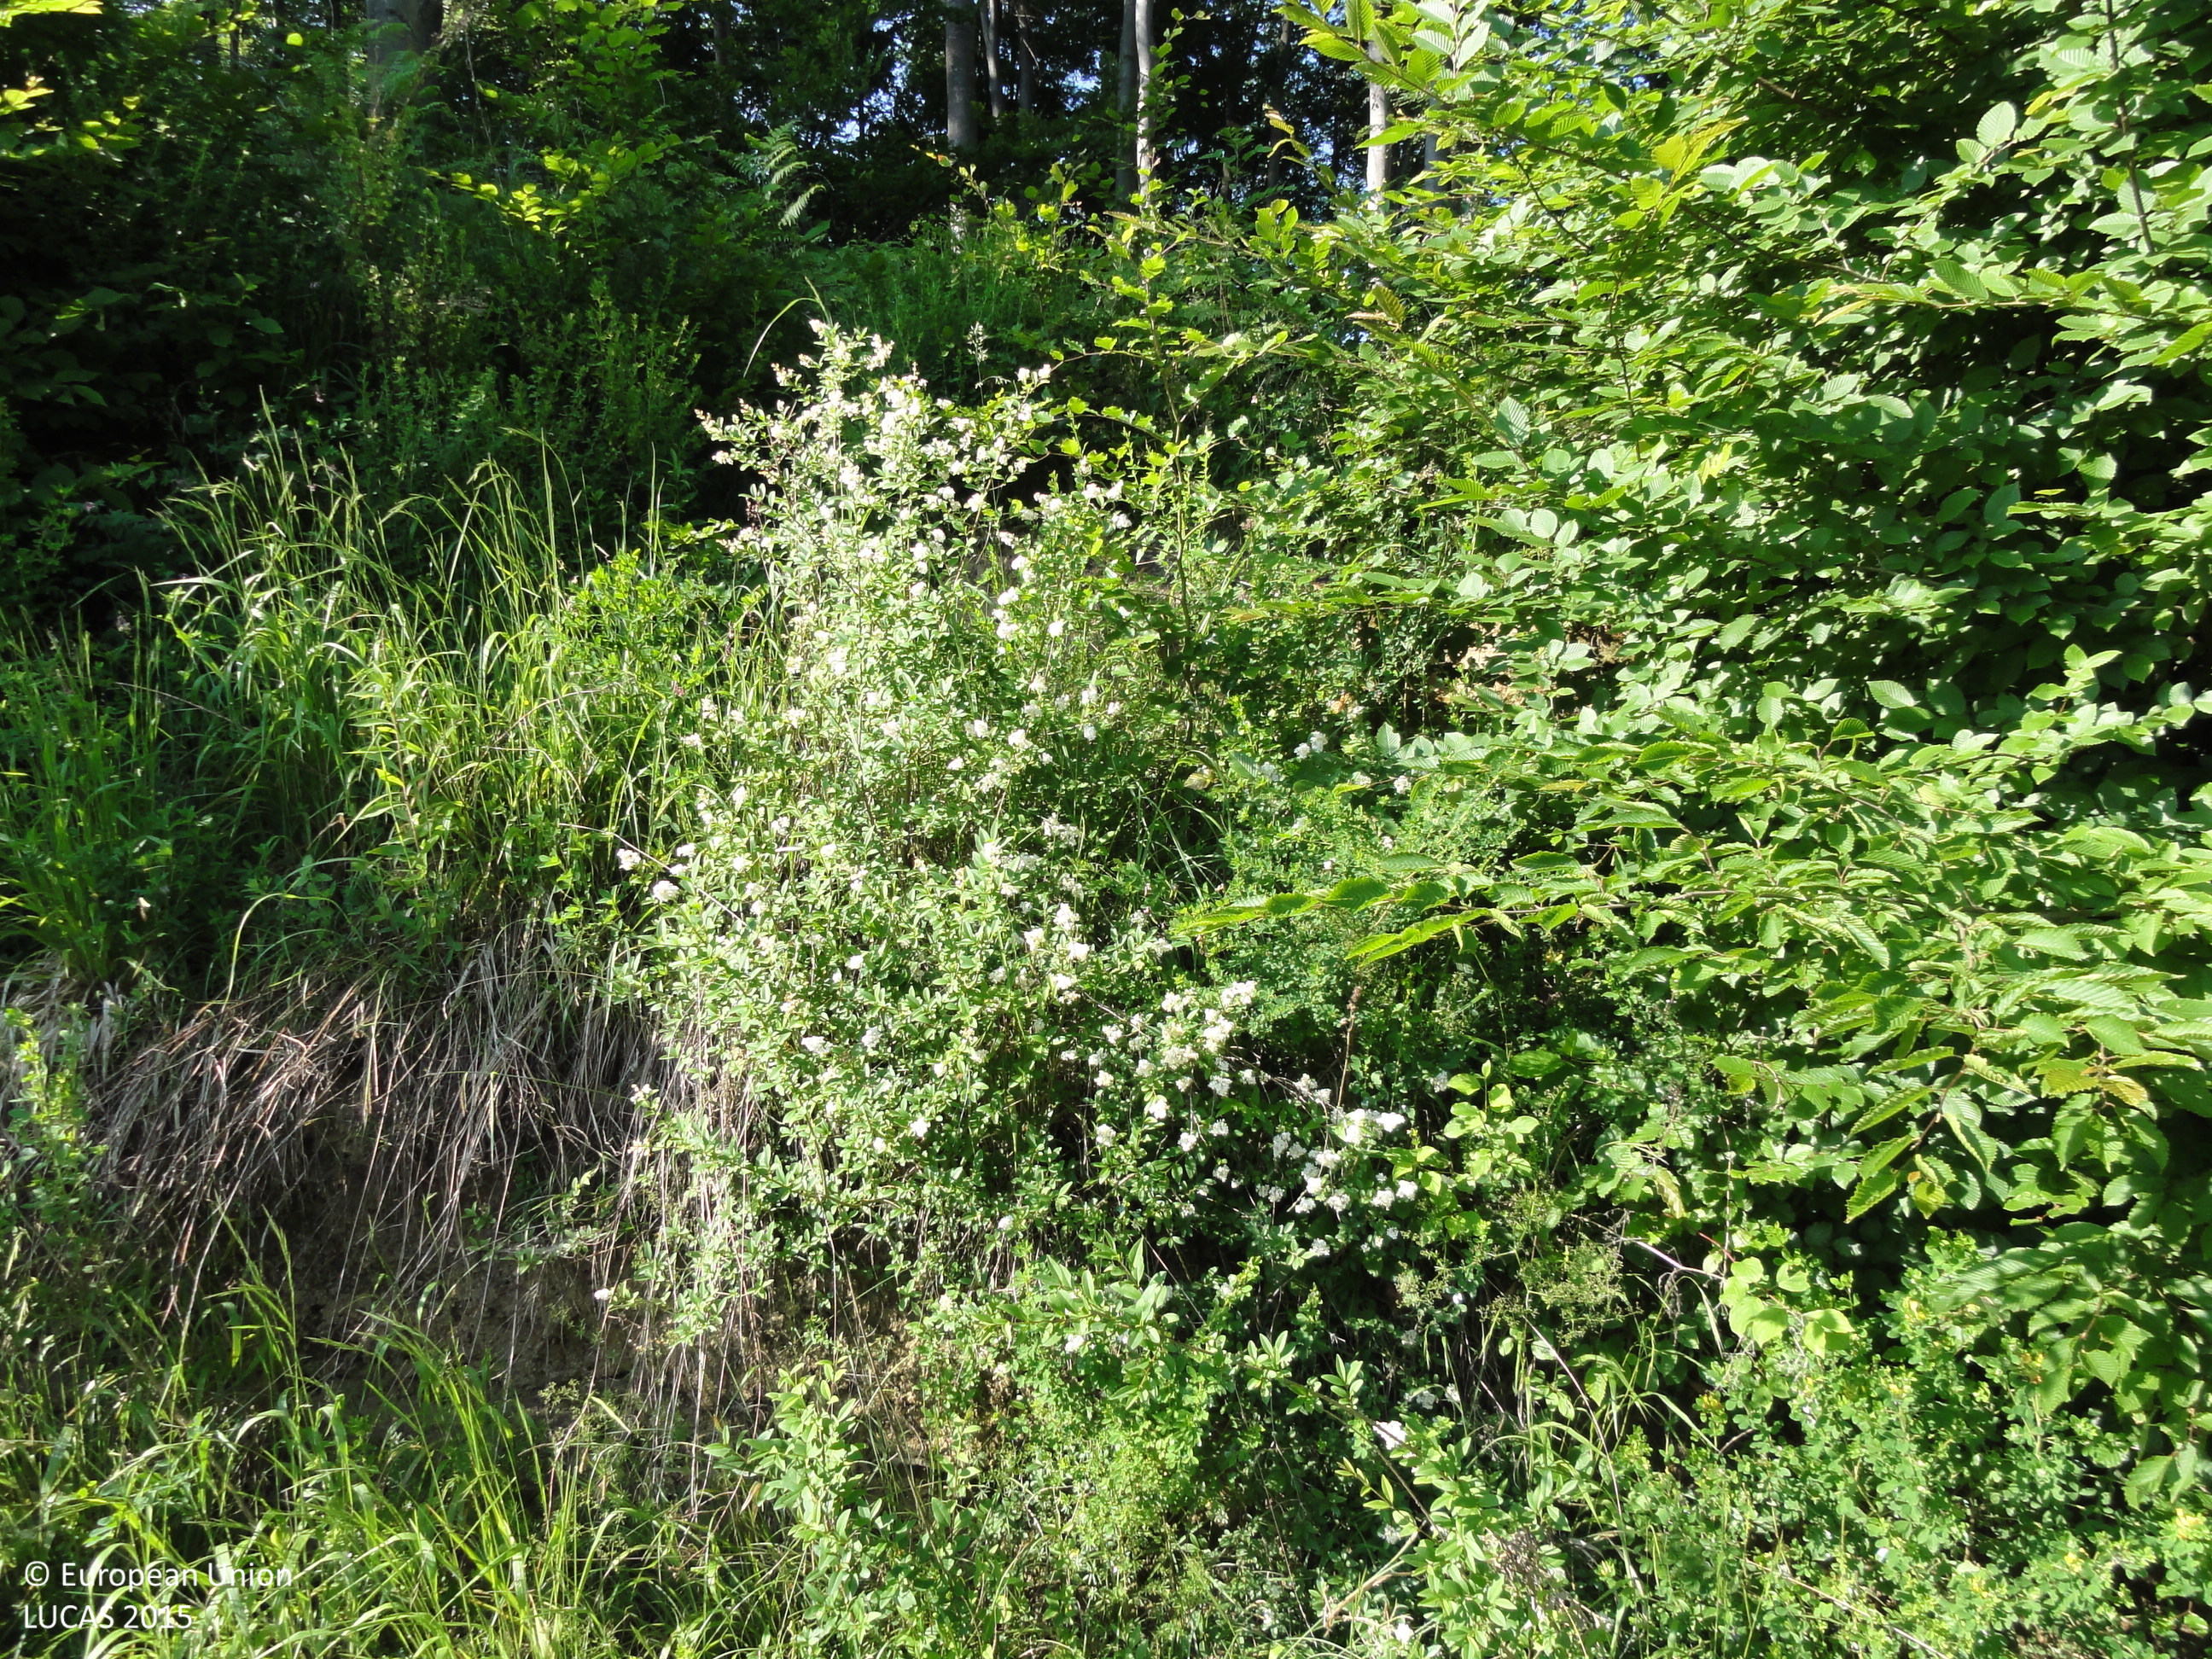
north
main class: Cropland
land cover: Apple fruit
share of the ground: > 75 %
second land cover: Grassland without tree/shrub cover
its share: > 75 %
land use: Agriculture (excluding fallow land and kitchen gardens)
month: June
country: SI
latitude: 46.4447
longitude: 16.1571
